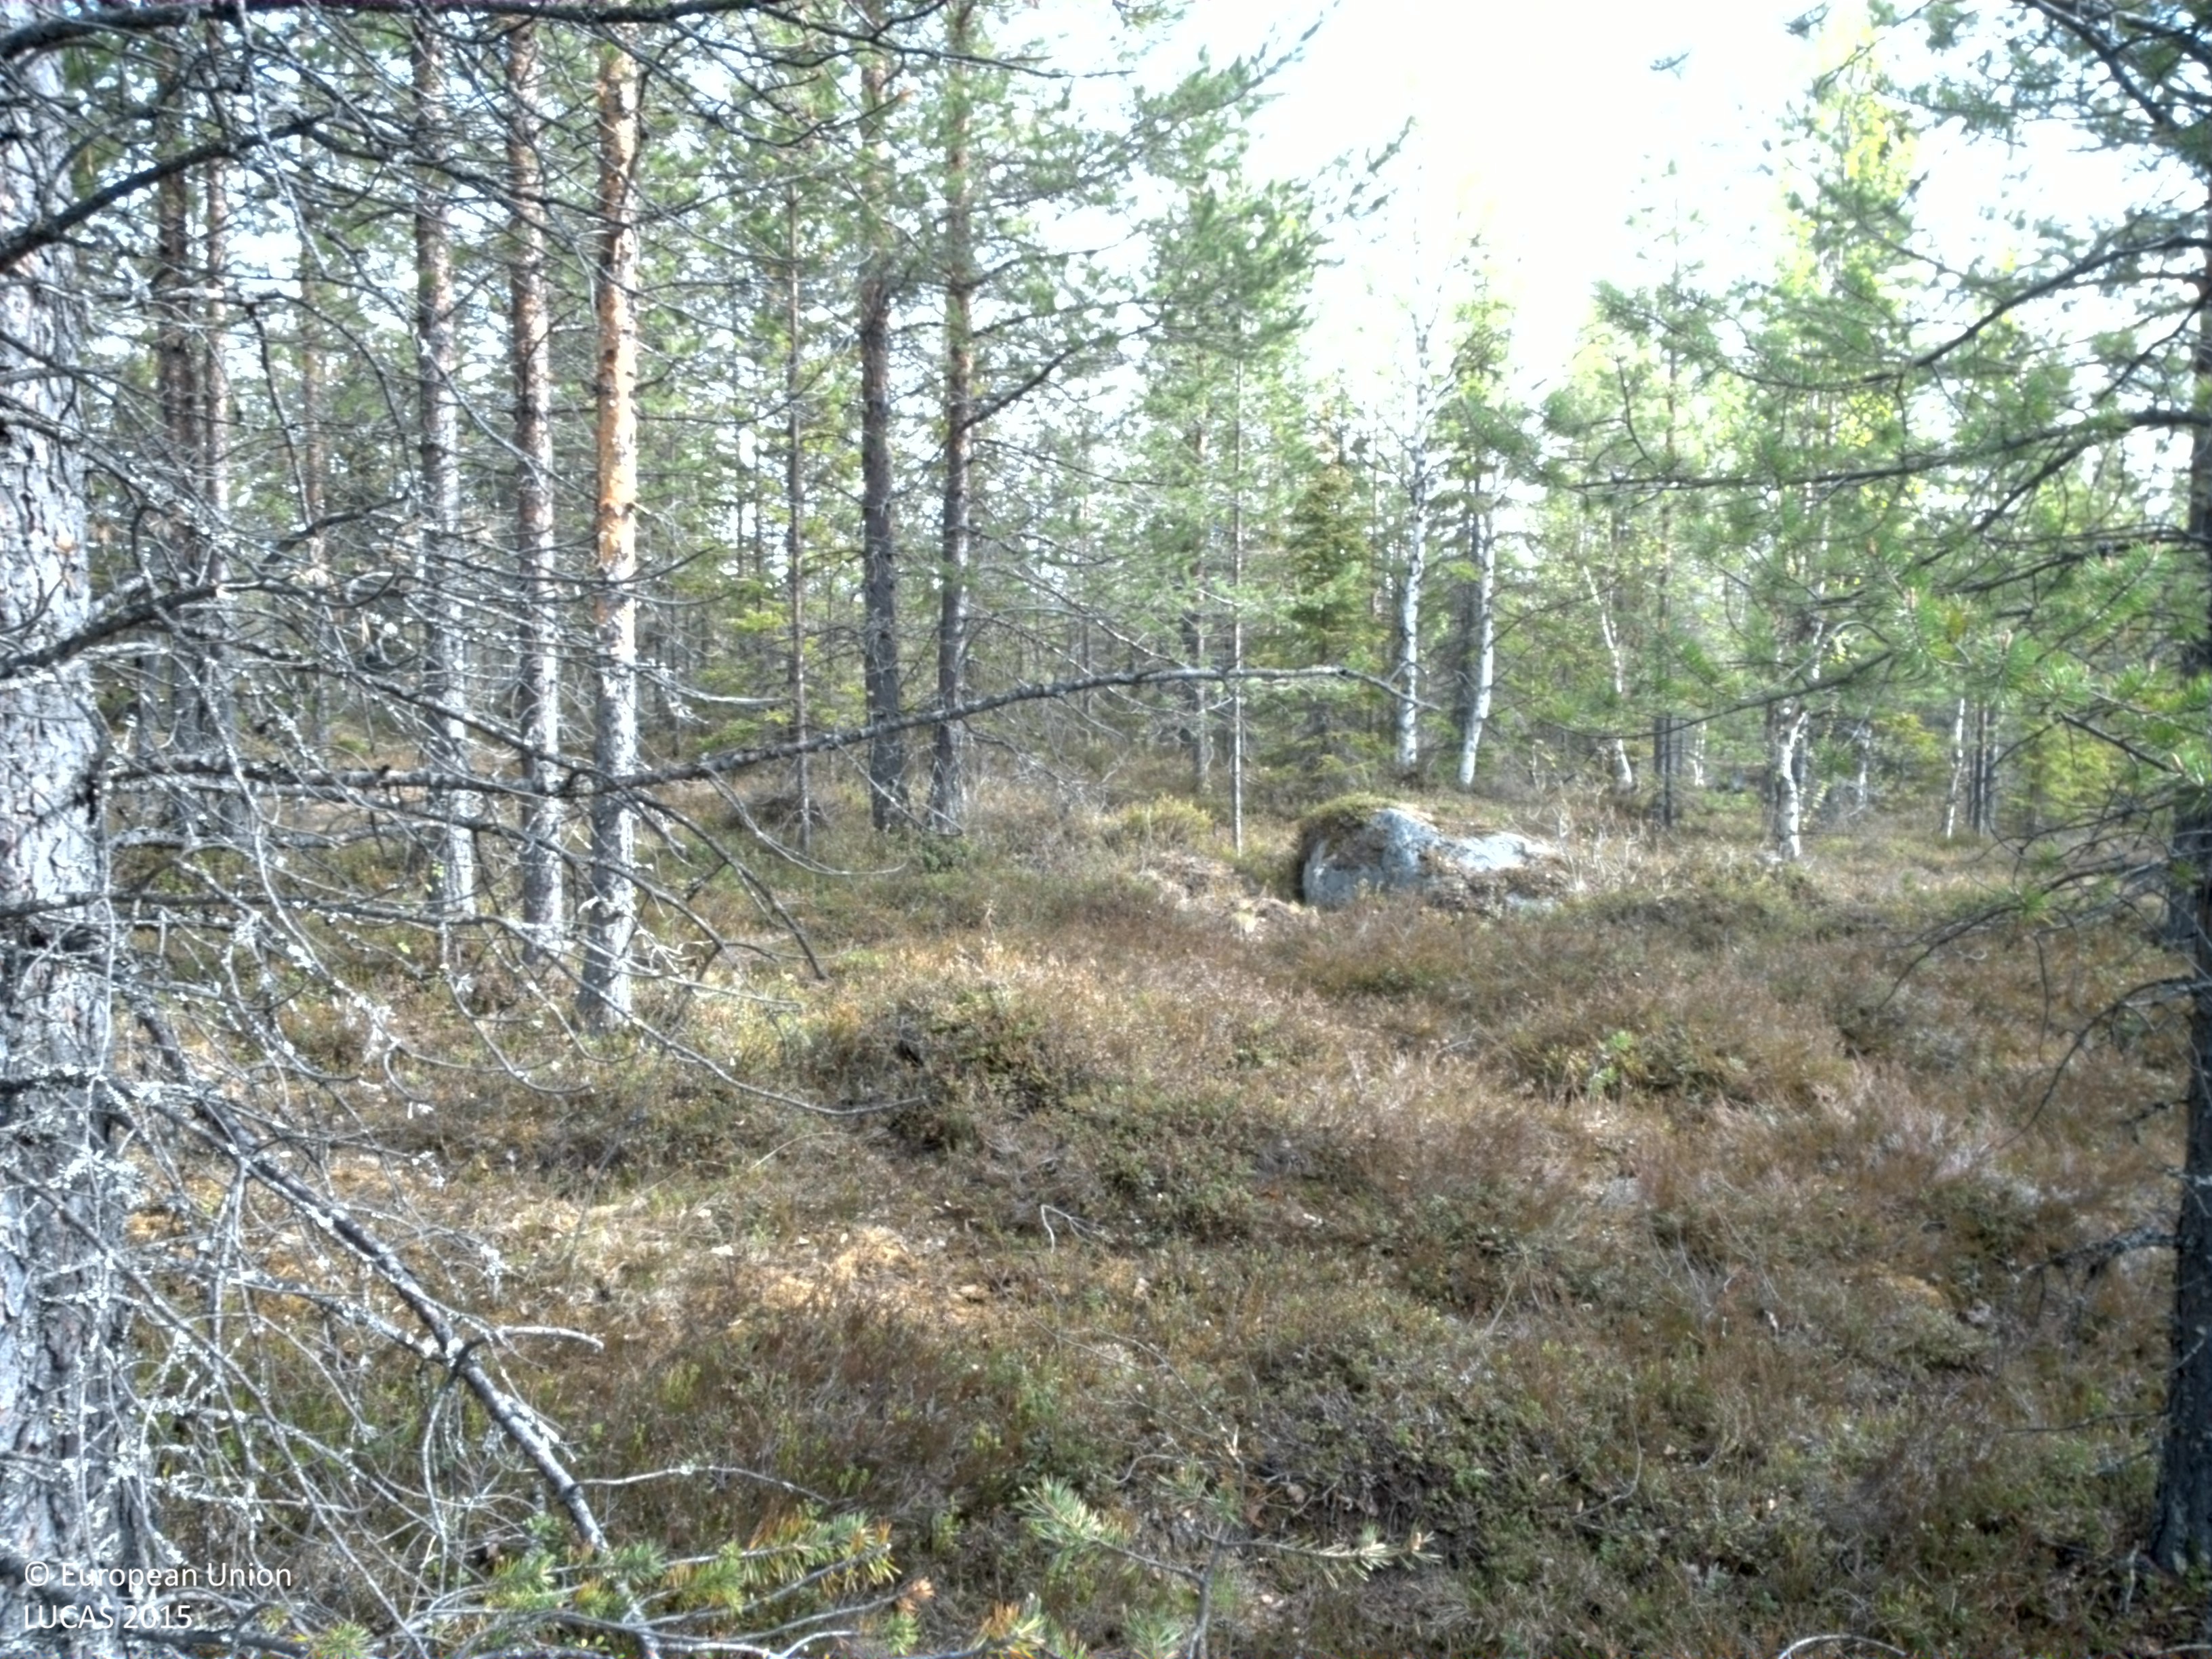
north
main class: Woodland
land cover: Pine dominated coniferous woodland
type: boreal forest
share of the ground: 25 - 50 %
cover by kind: shrubs 50 %, coniferous forest trees 45 %, broadleaved forest trees 5 %
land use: Forestry
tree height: > 5 m
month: June
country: SE
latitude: 65.8149
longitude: 19.6944
